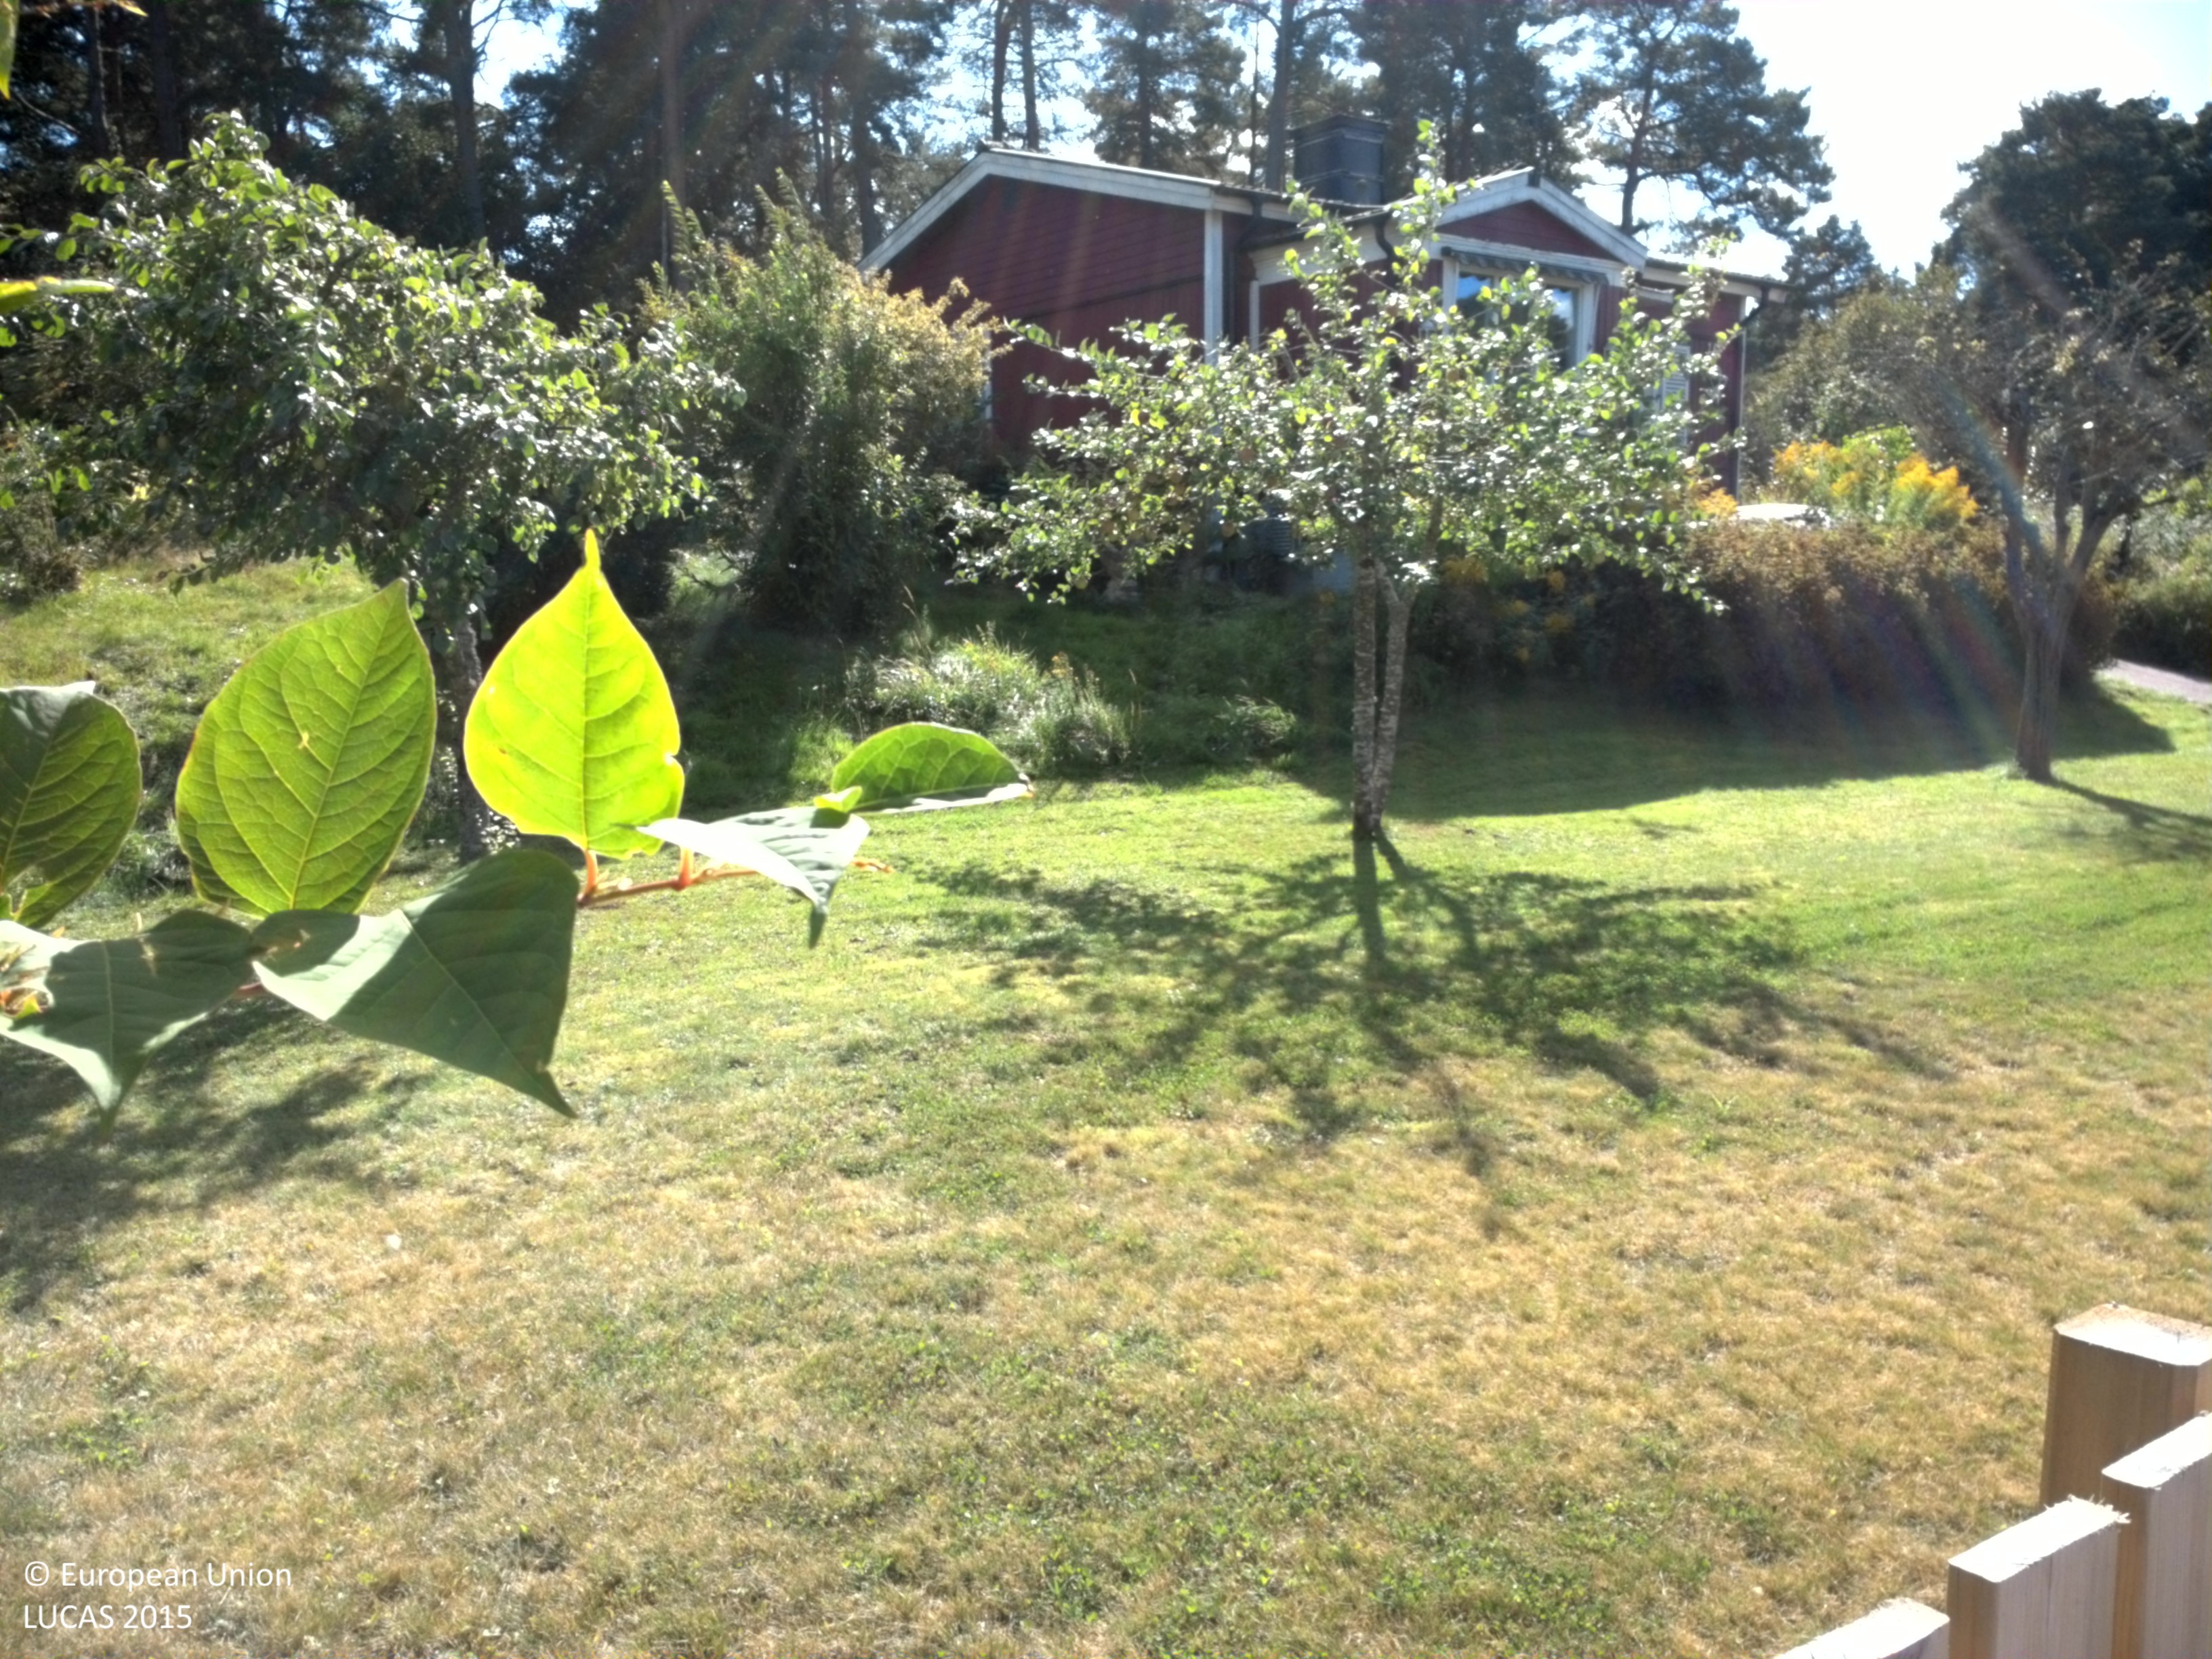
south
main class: Grassland
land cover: Grassland with sparse tree/shrub cover
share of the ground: > 75 %
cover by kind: herbaceous plants 95 %, broadleaved forest trees 5 %
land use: Residential
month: August
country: SE
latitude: 59.6399
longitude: 17.1063
